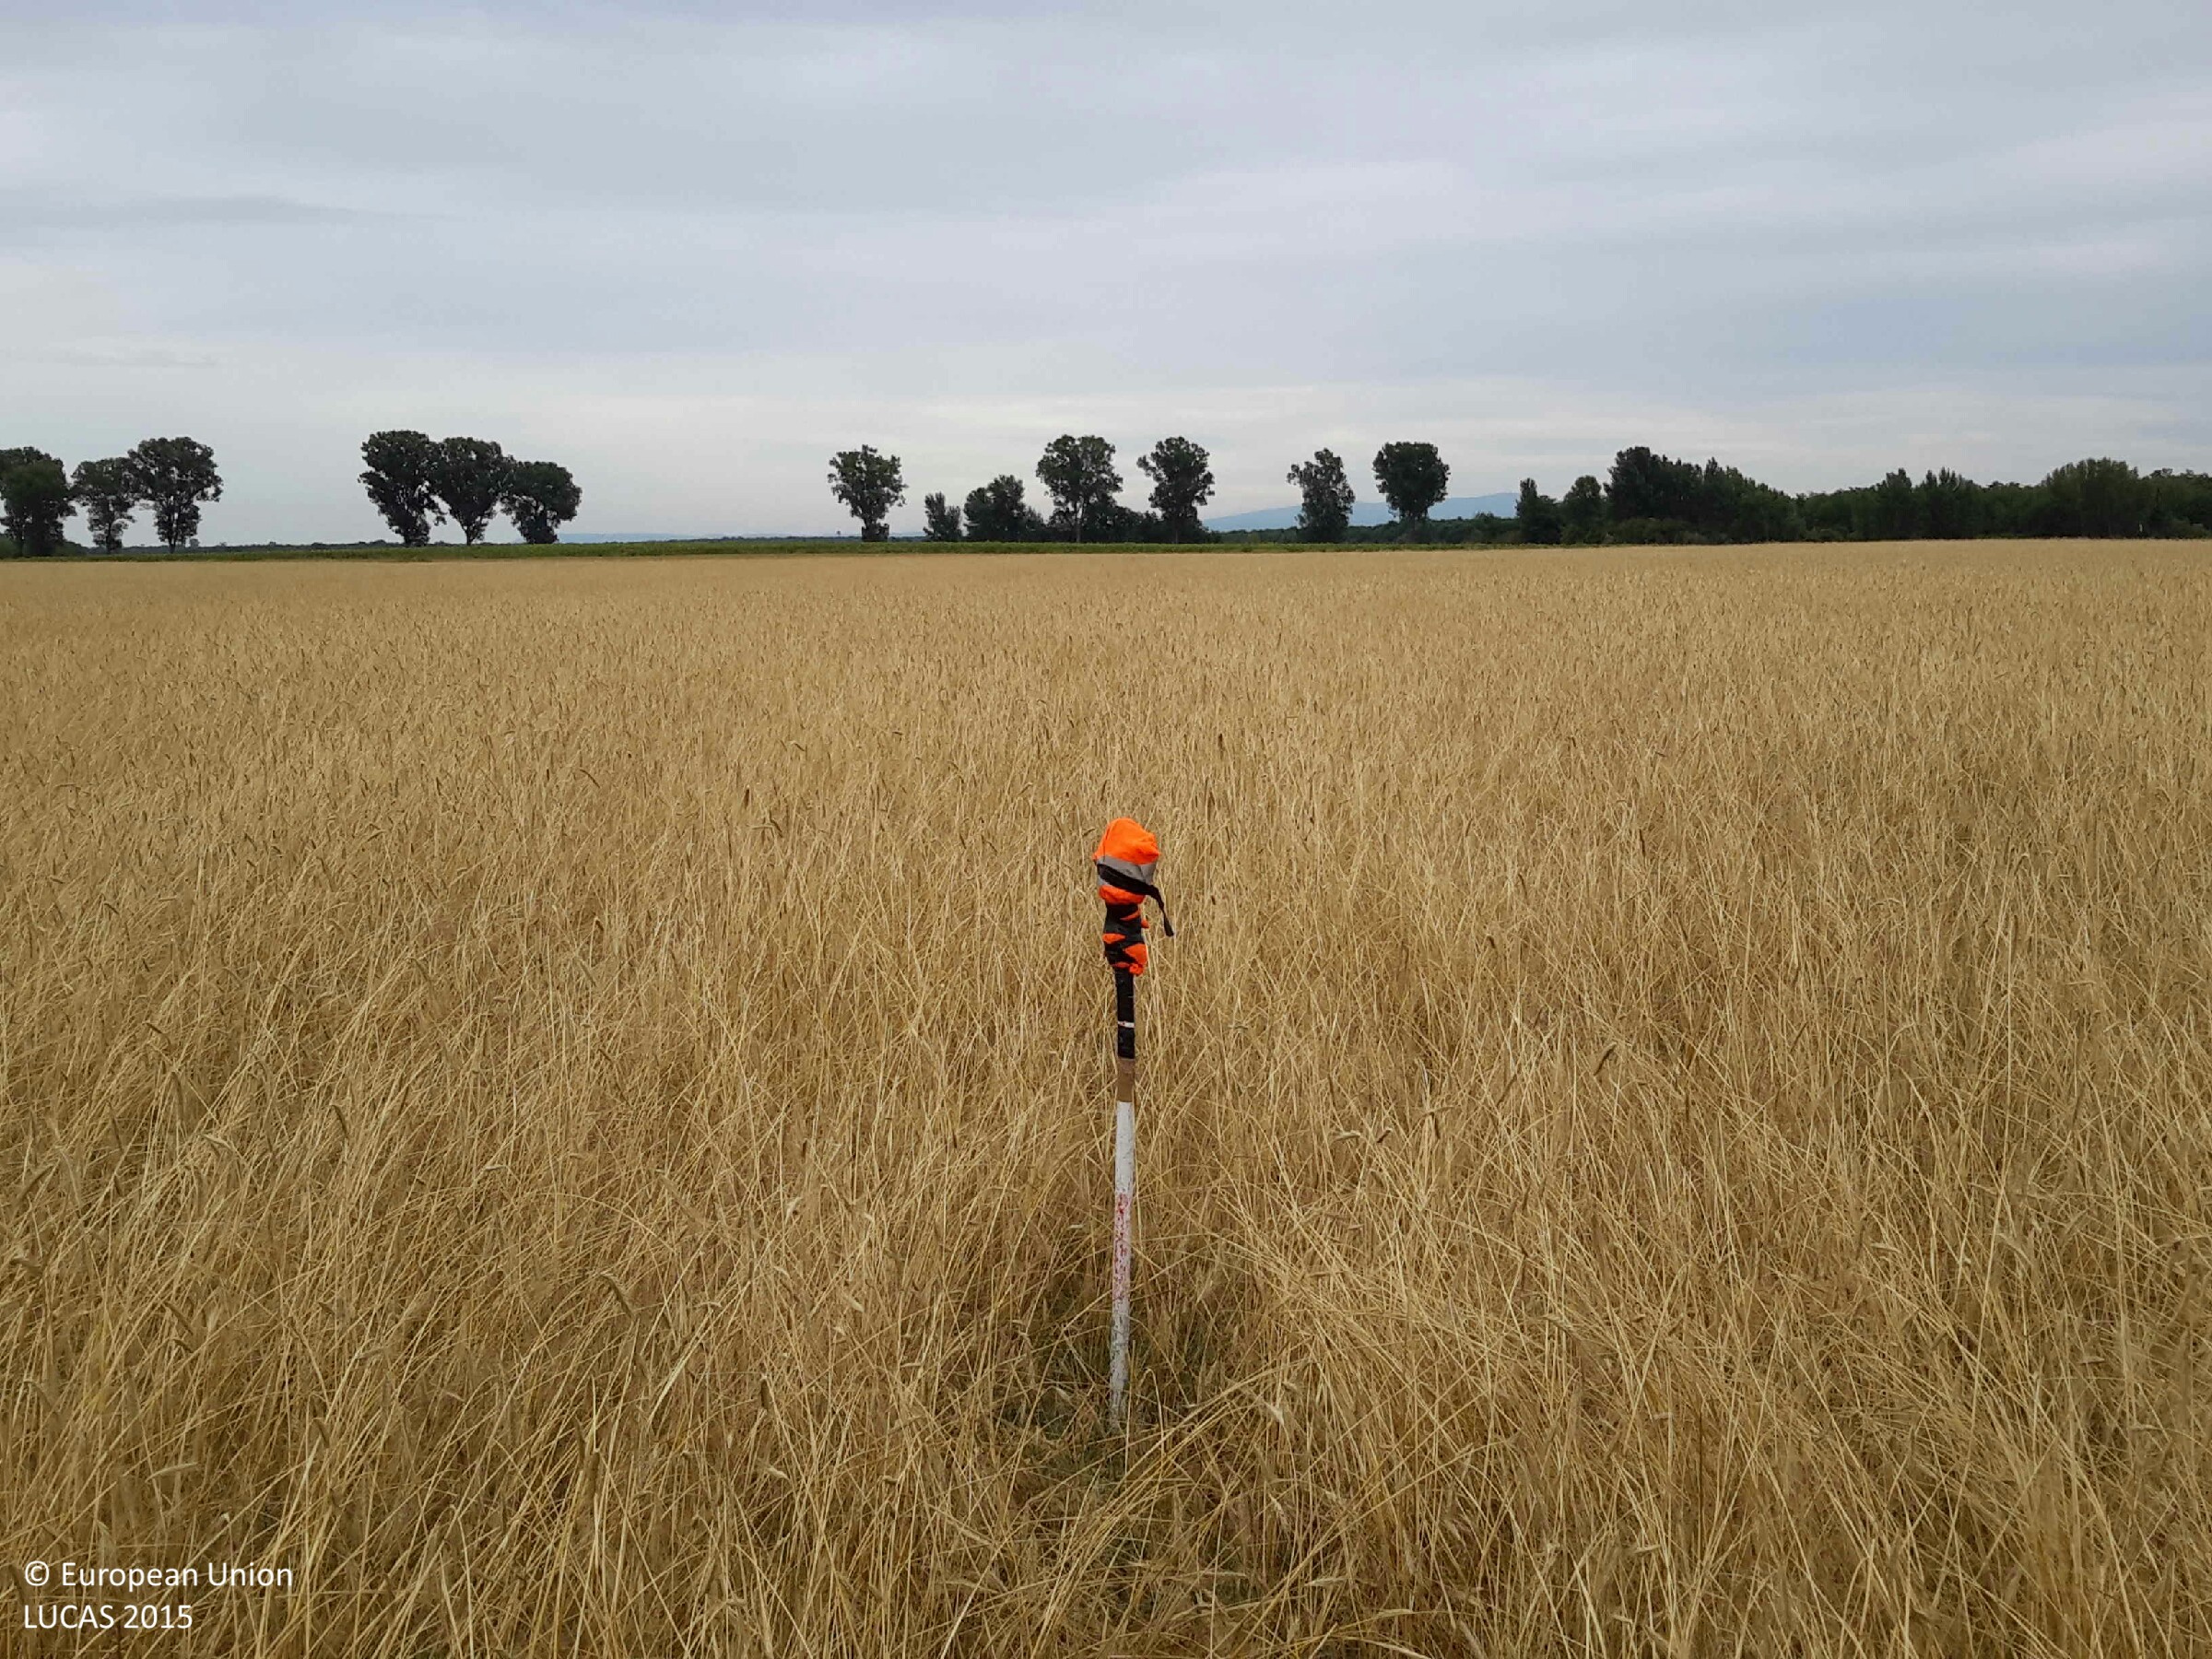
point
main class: Cropland
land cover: Barley
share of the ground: > 75 %
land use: Agriculture (excluding fallow land and kitchen gardens)
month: July
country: HU
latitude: 47.4276
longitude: 17.4714
